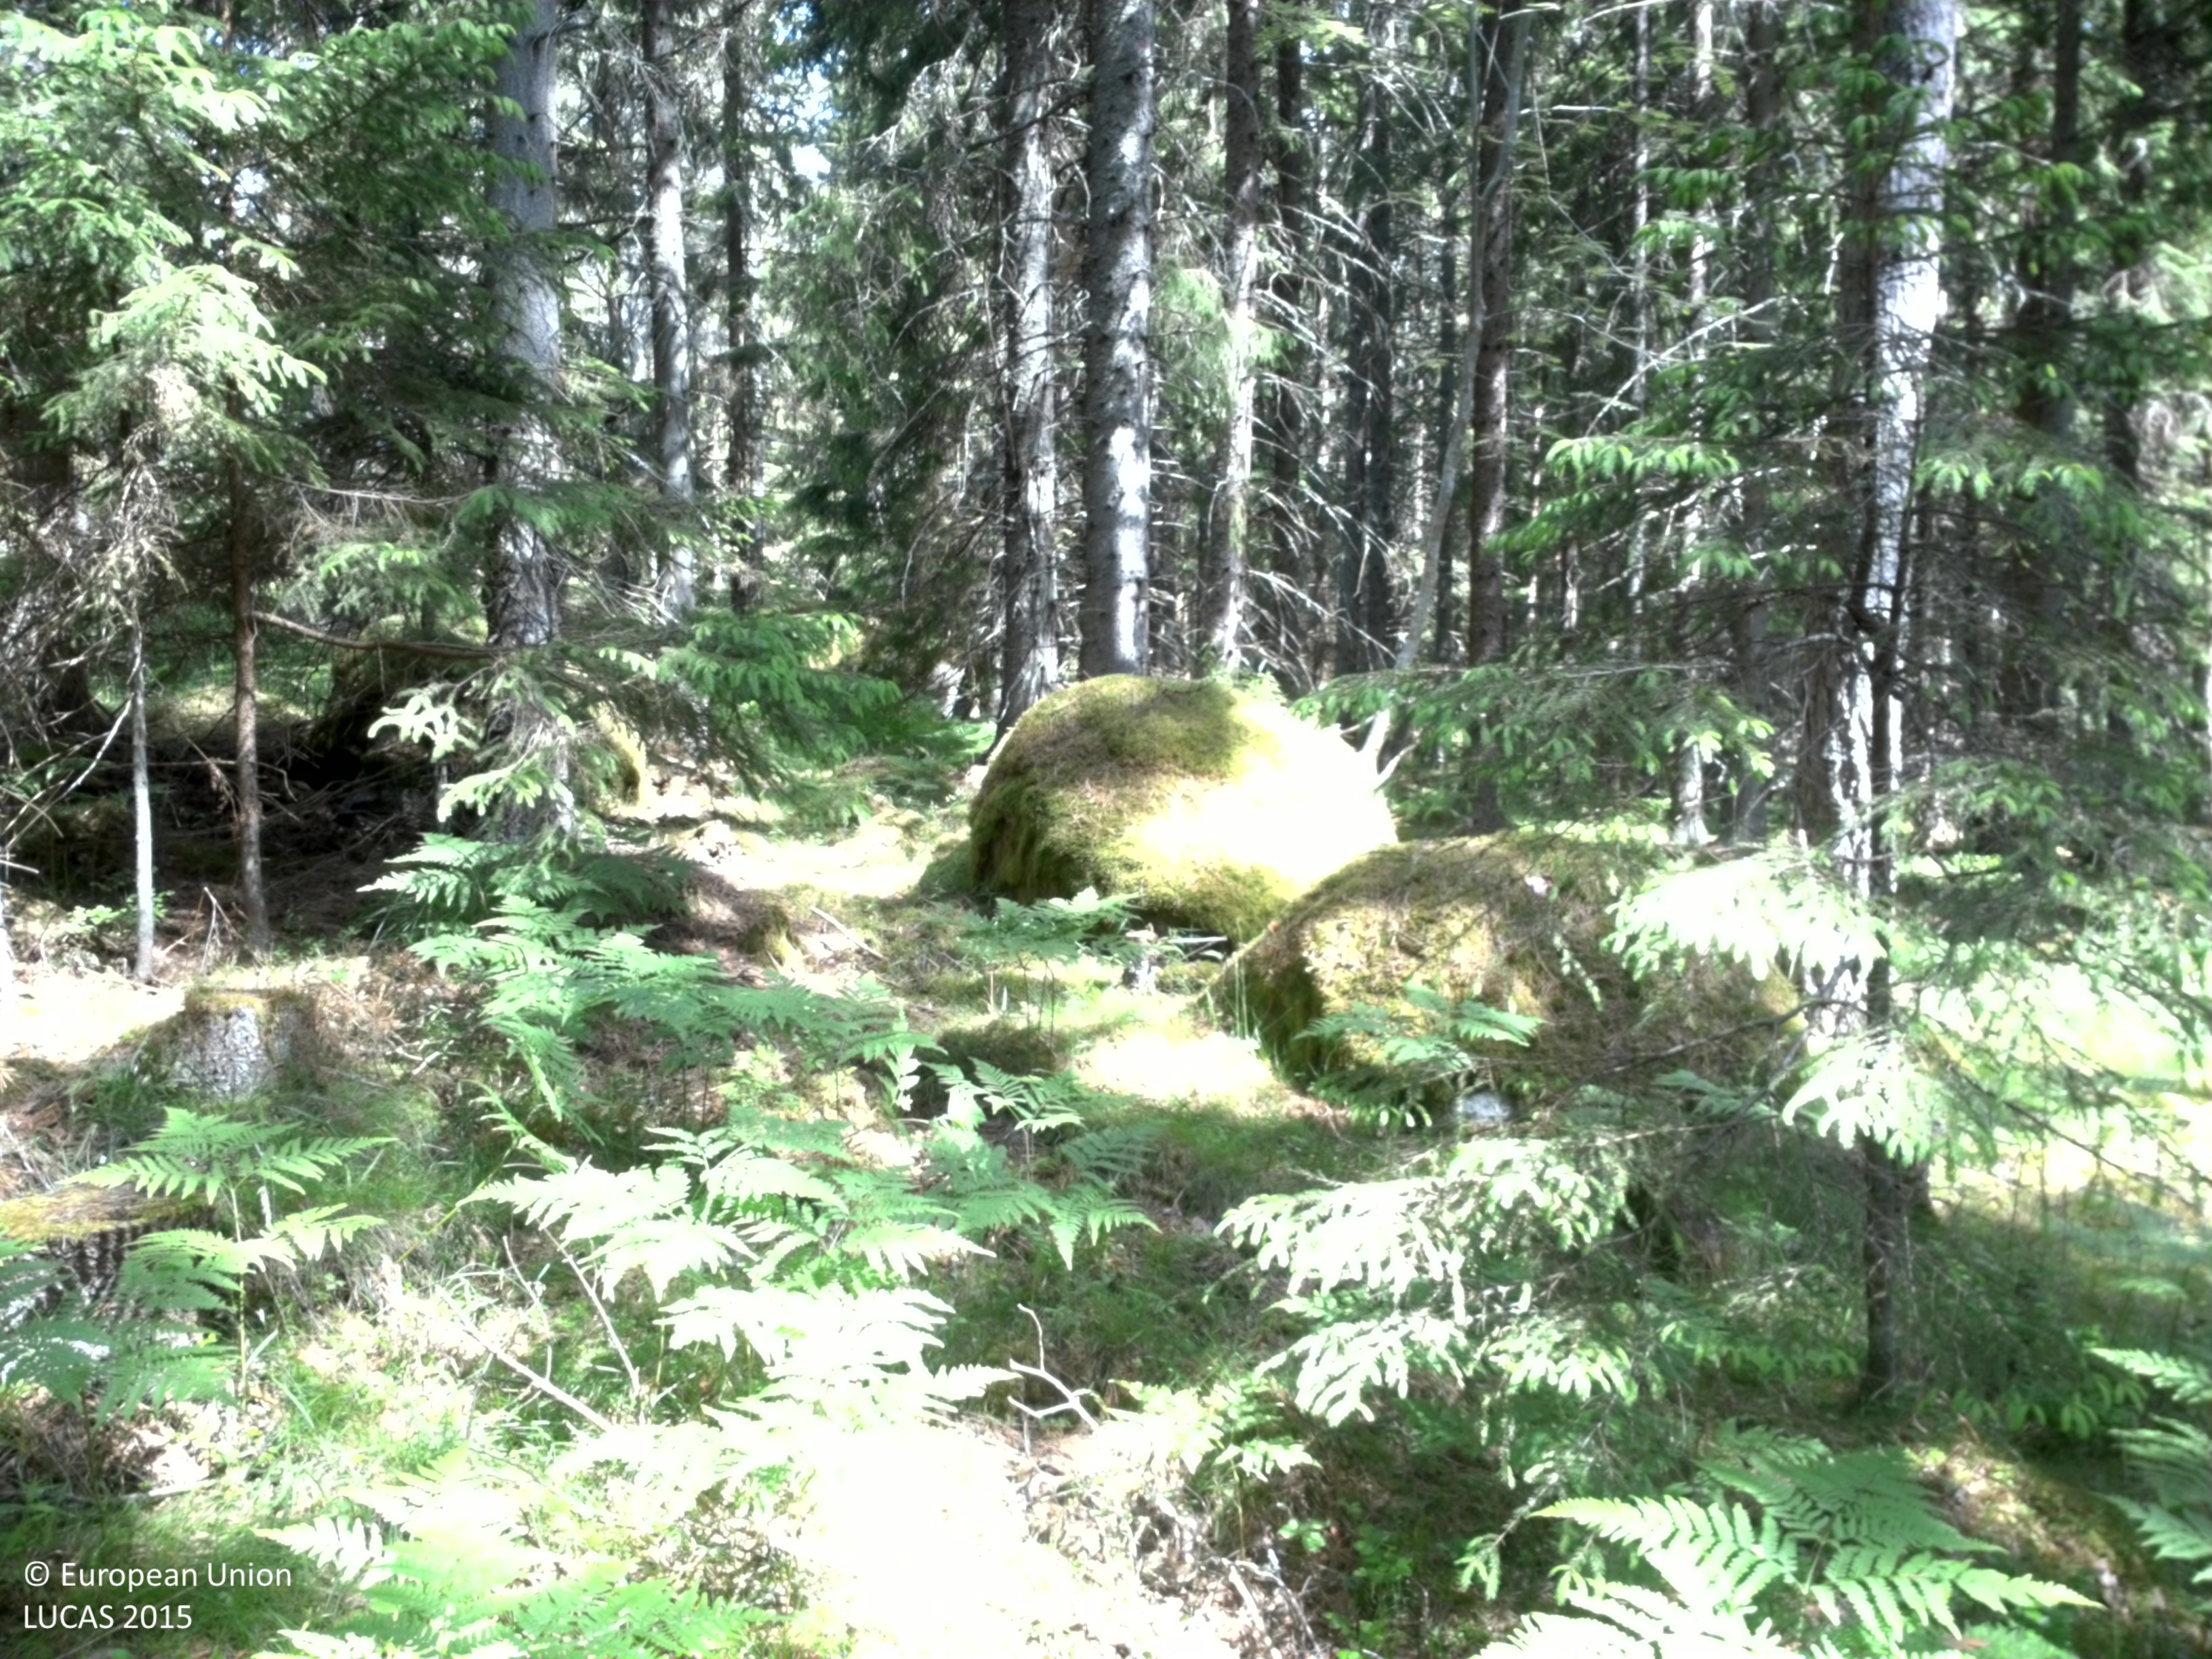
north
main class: Woodland
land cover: Pine dominated coniferous woodland
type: boreal forest
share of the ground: 10 - 25 %
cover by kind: herbaceous plants 60 %, coniferous forest trees 20 %, lichens and mosses 20 %
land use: Community services
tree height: > 5 m
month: June
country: SE
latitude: 58.5974
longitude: 15.4139
